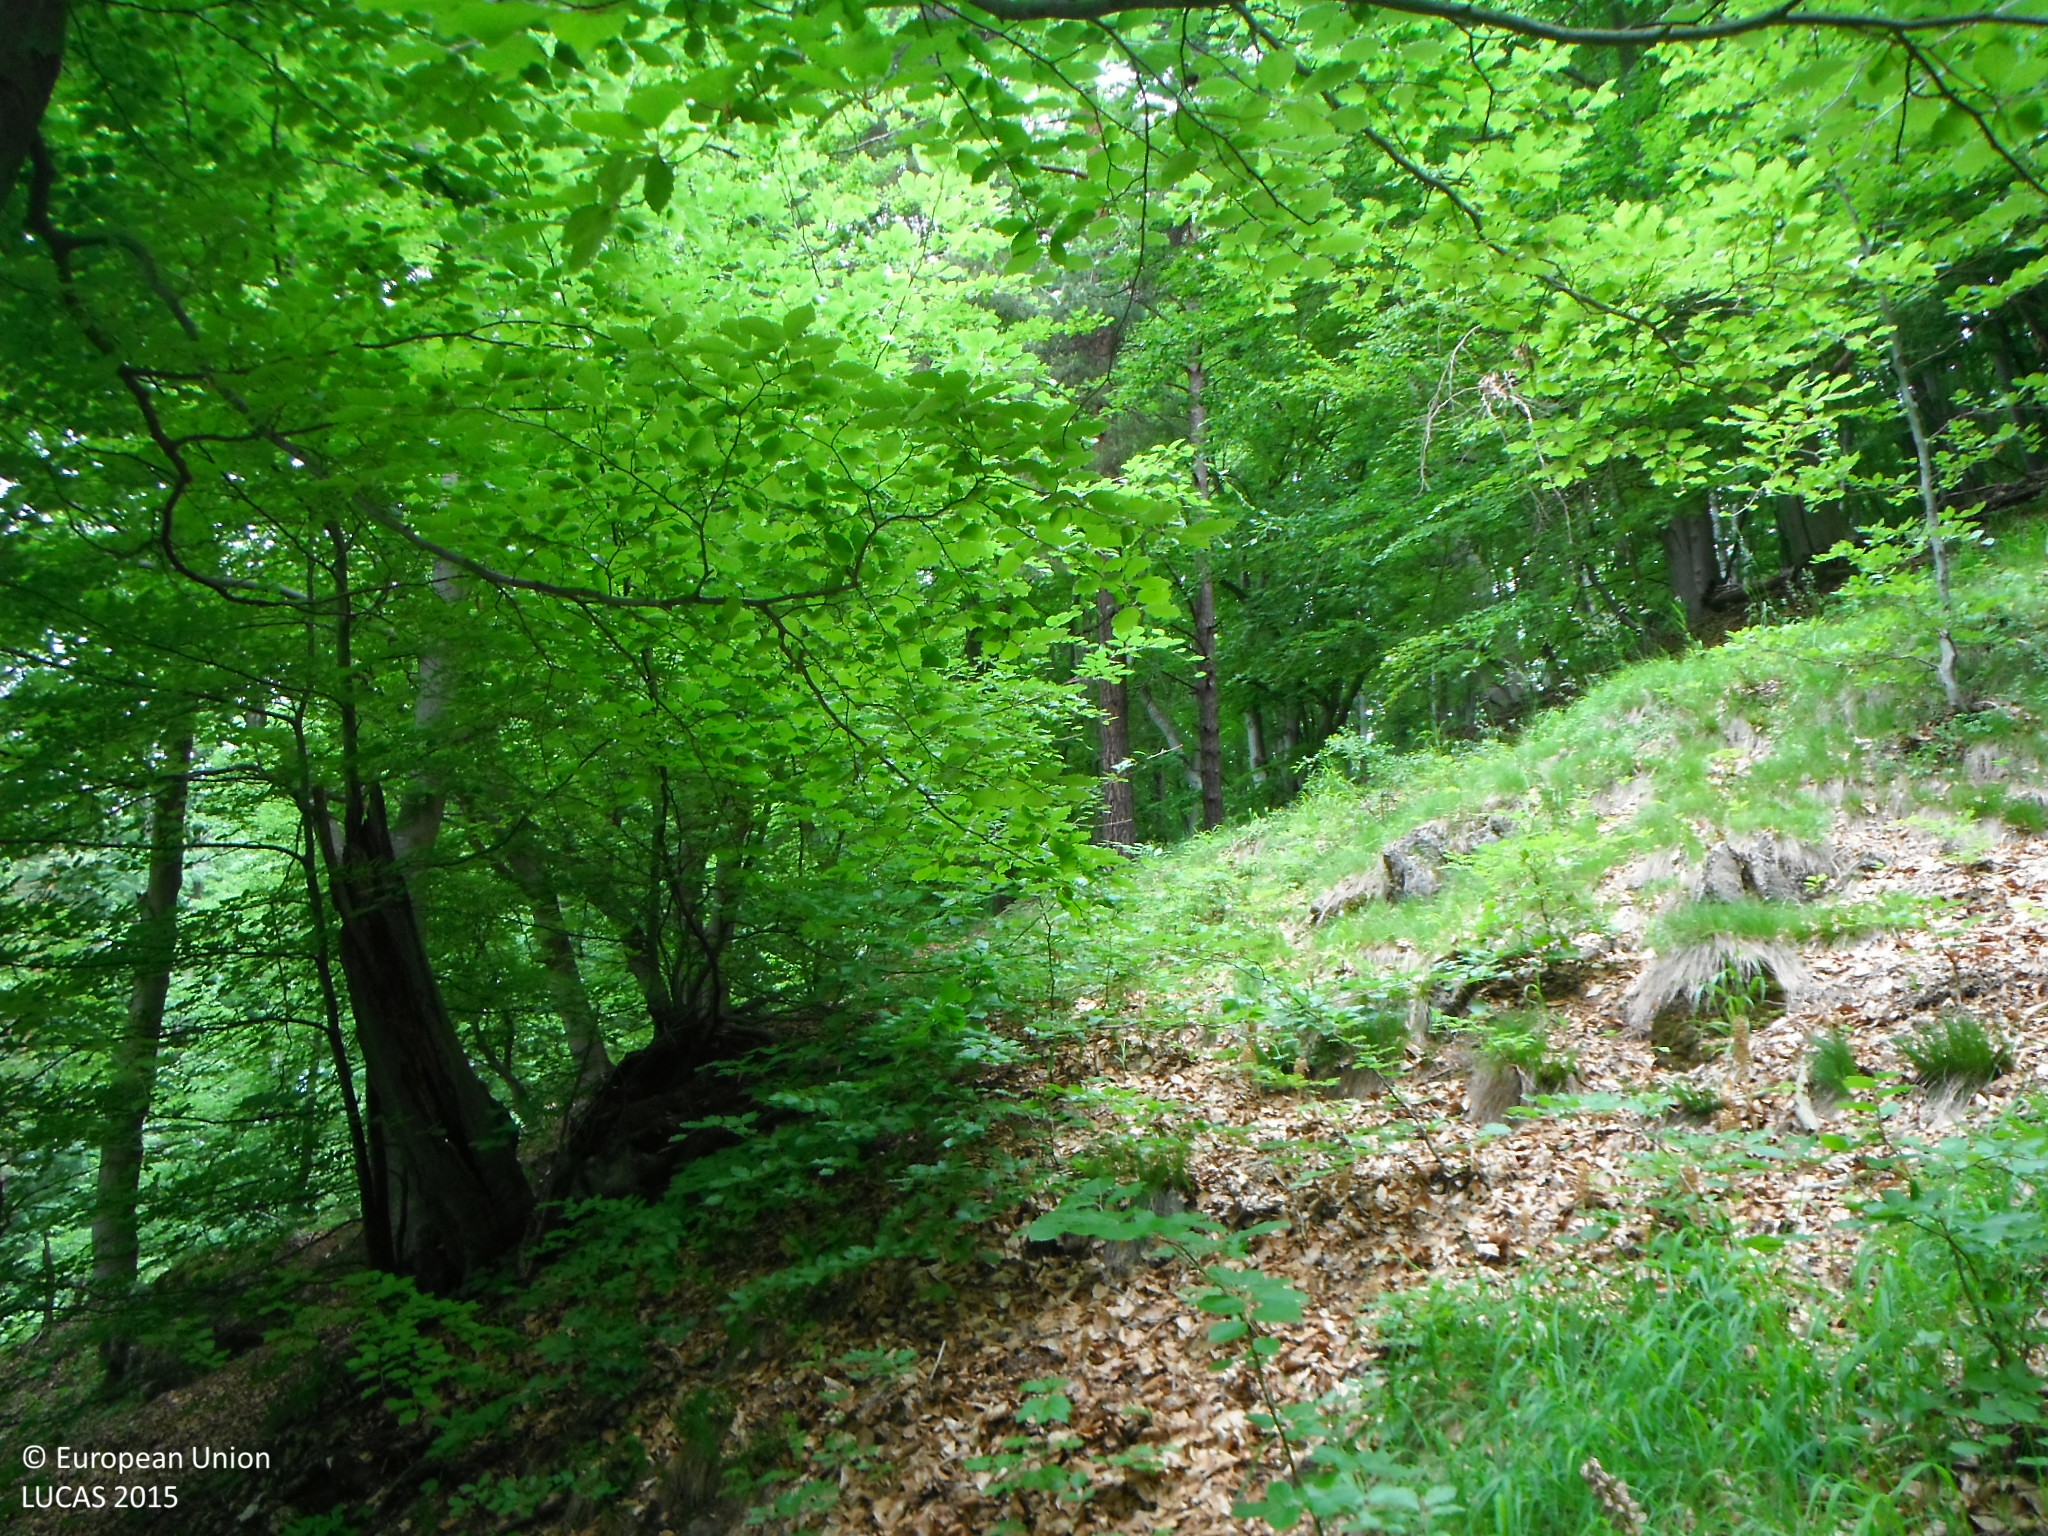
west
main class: Woodland
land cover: Broadleaved woodland
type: mountainous beech forest
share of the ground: > 75 %
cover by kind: broadleaved forest trees 100 %
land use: Forestry
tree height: > 5 m
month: June
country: SK
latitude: 48.8034
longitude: 19.3506
